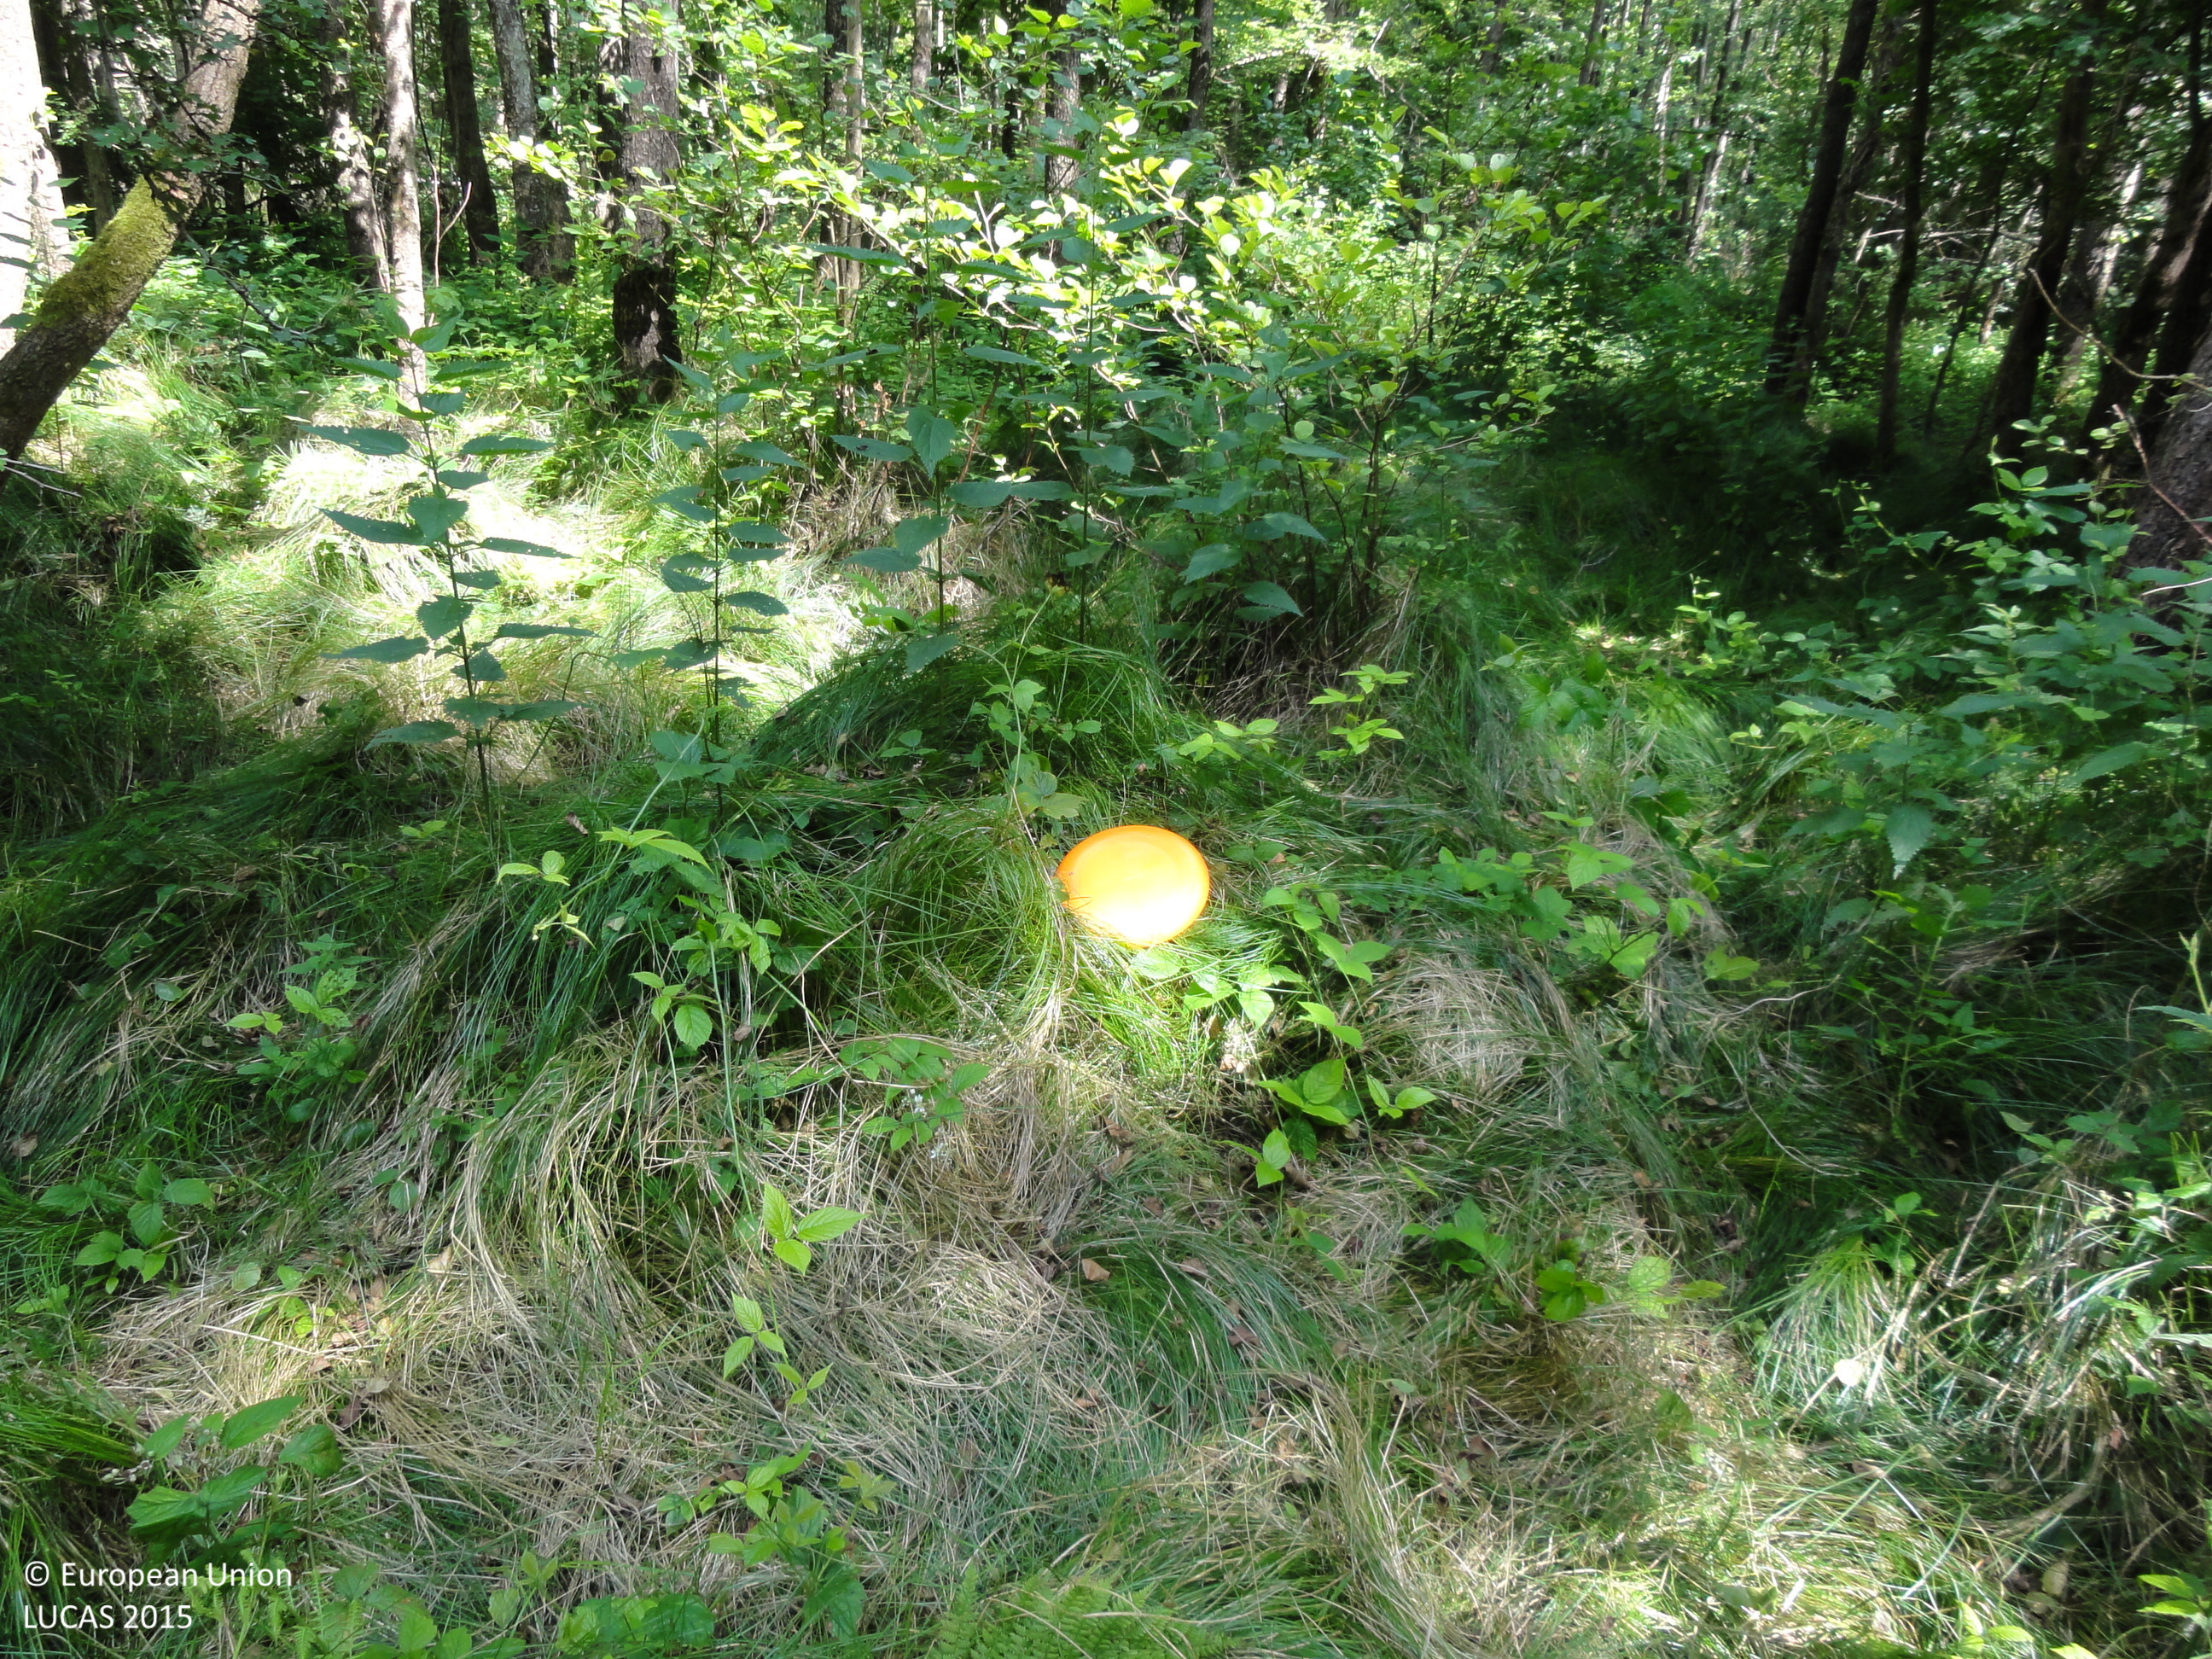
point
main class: Woodland
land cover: Broadleaved woodland
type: non-riverine alder, birch or aspen forest
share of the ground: > 75 %
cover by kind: broadleaved forest trees 95 %, herbaceous plants 5 %
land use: Forestry
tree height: > 5 m
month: June
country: SI
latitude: 46.5925
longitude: 16.4098
